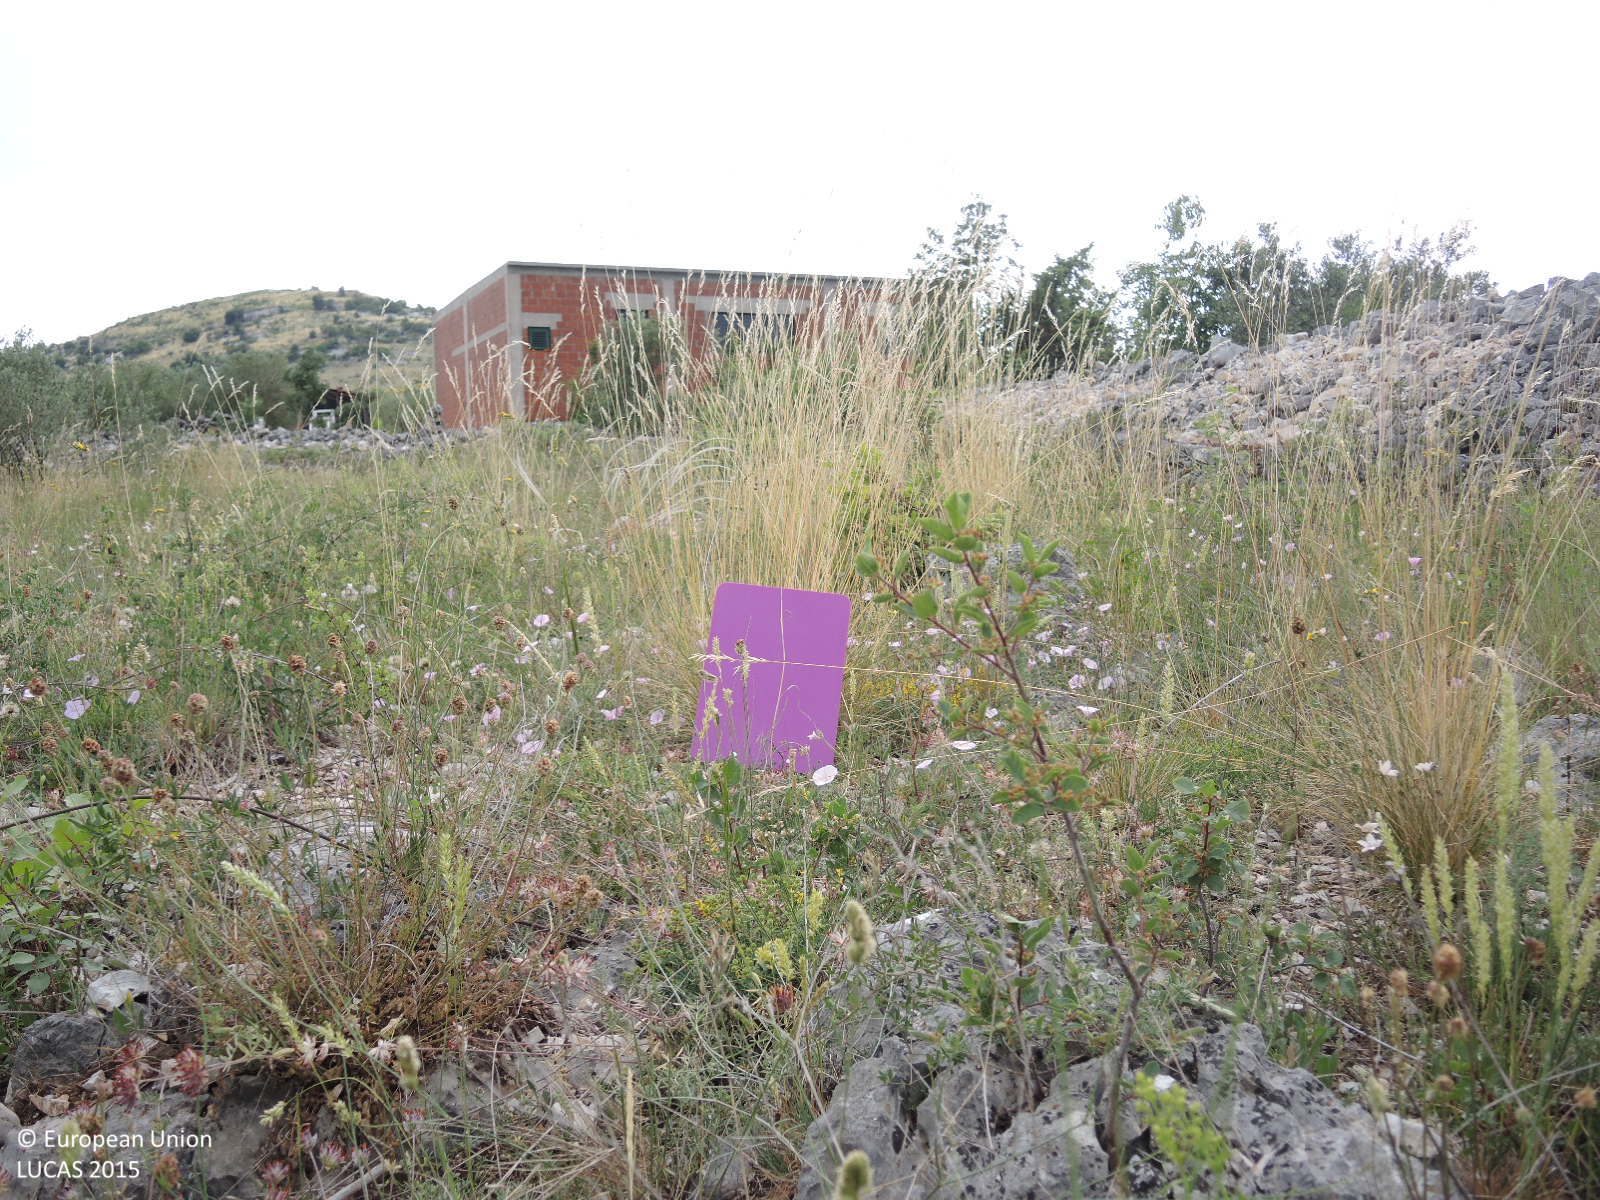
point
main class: Cropland
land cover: Olive groves
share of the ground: 10 - 25 %
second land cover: Spontaneously vegetated surfaces
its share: > 75 %
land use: Agriculture (excluding fallow land and kitchen gardens)
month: May
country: HR
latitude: 43.8088
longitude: 15.7965
